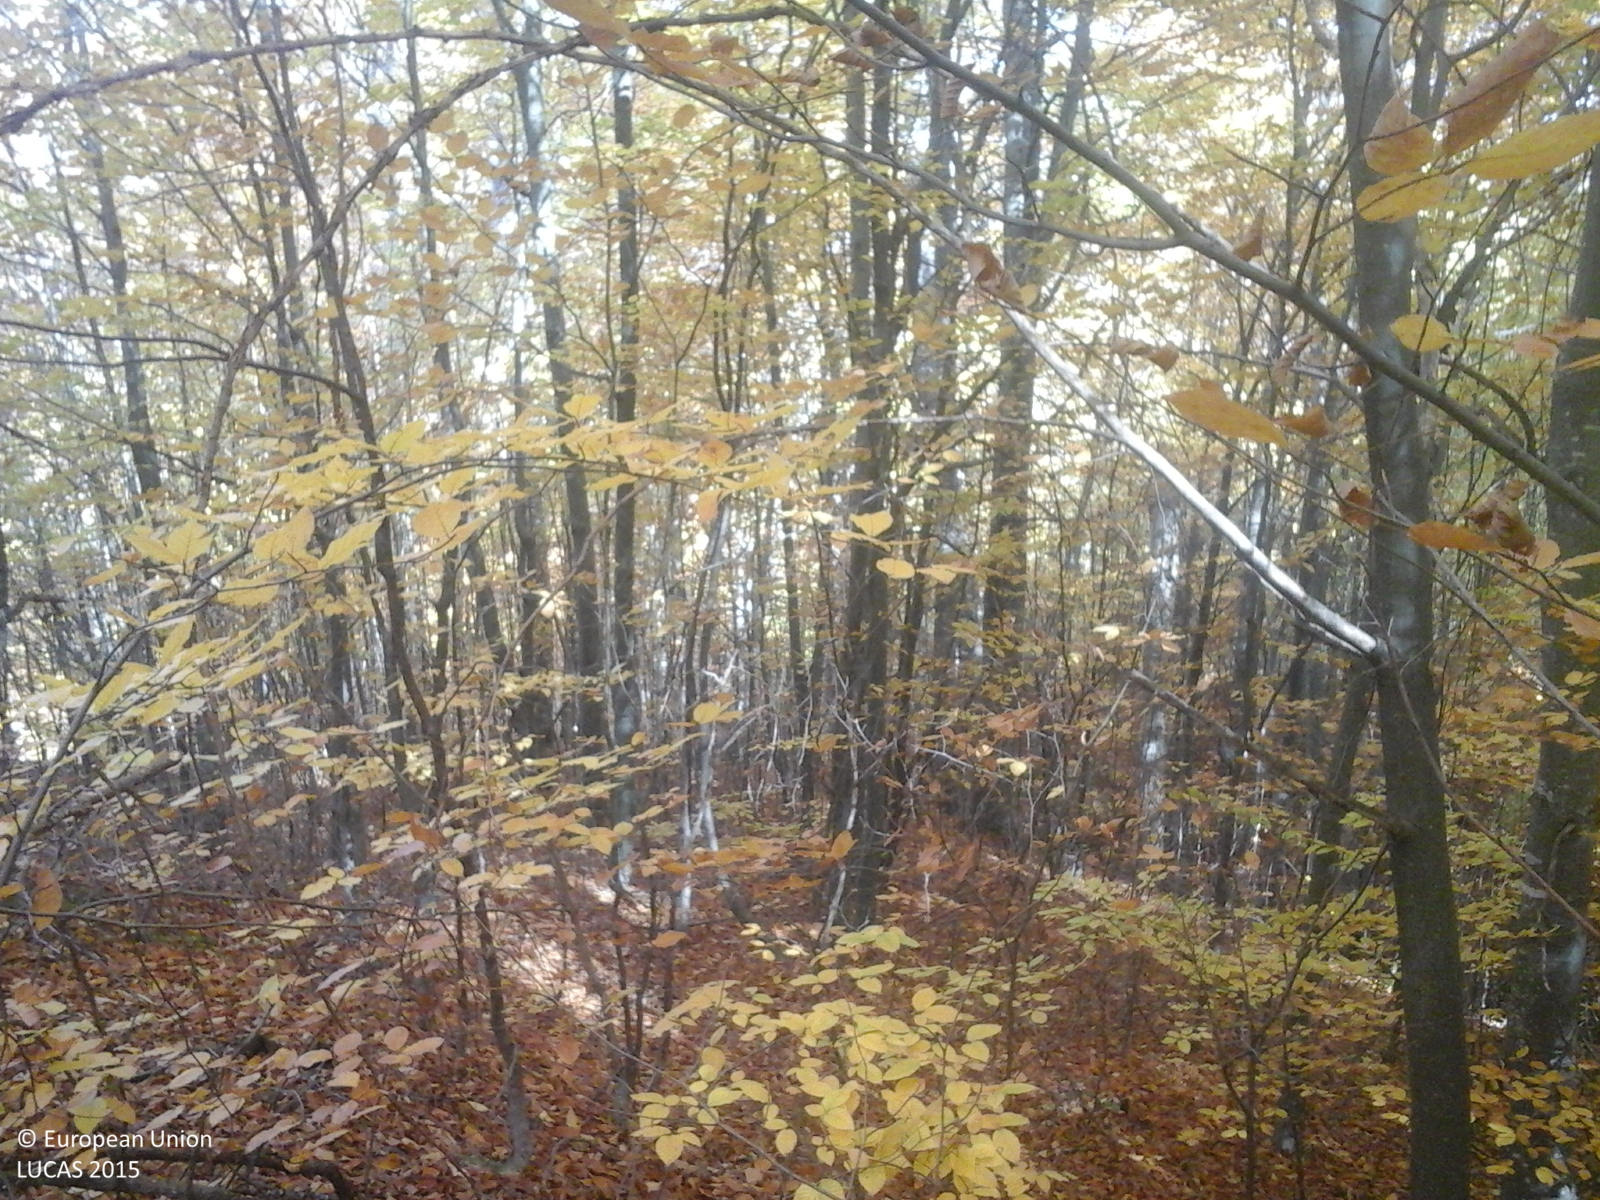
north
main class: Woodland
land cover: Broadleaved woodland
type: beech forest
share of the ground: > 75 %
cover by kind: broadleaved forest trees 100 %
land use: Forestry
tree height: > 5 m
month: October
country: RO
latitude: 45.9246
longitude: 26.5988
